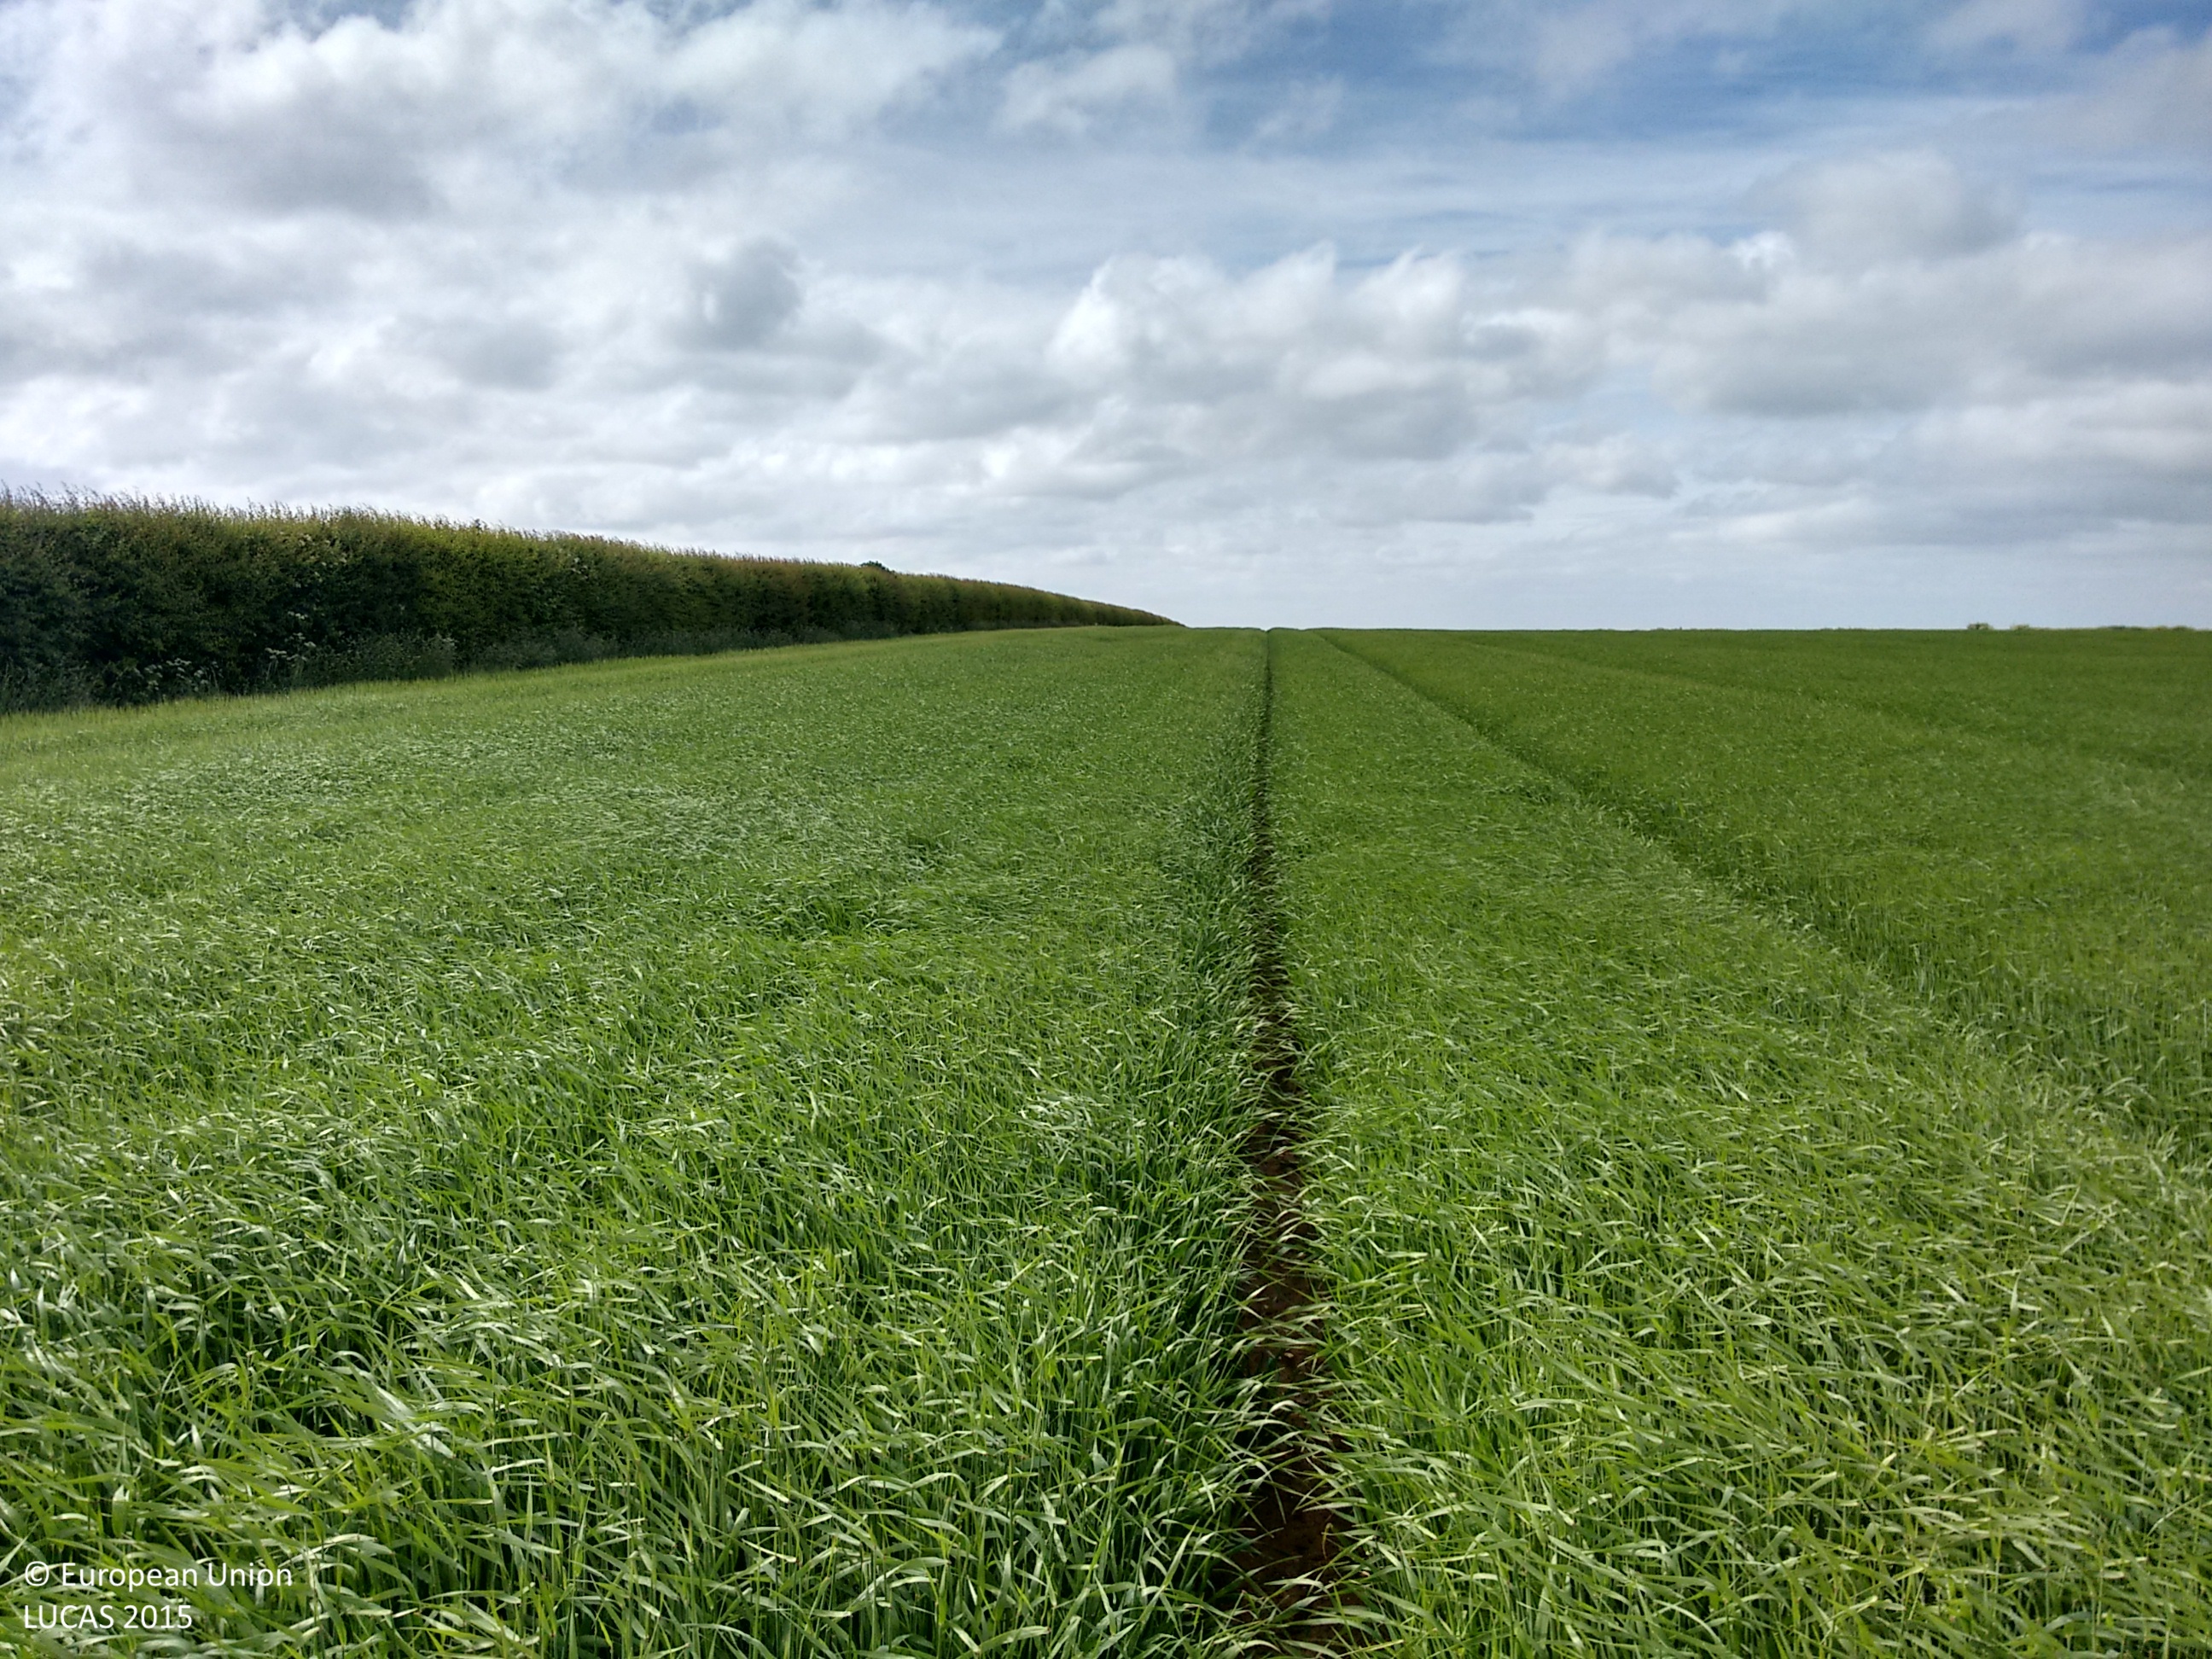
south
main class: Cropland
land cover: Barley
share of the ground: > 75 %
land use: Agriculture (excluding fallow land and kitchen gardens)
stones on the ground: < 10 %
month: June
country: GB
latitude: 54.1447
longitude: -0.2444
